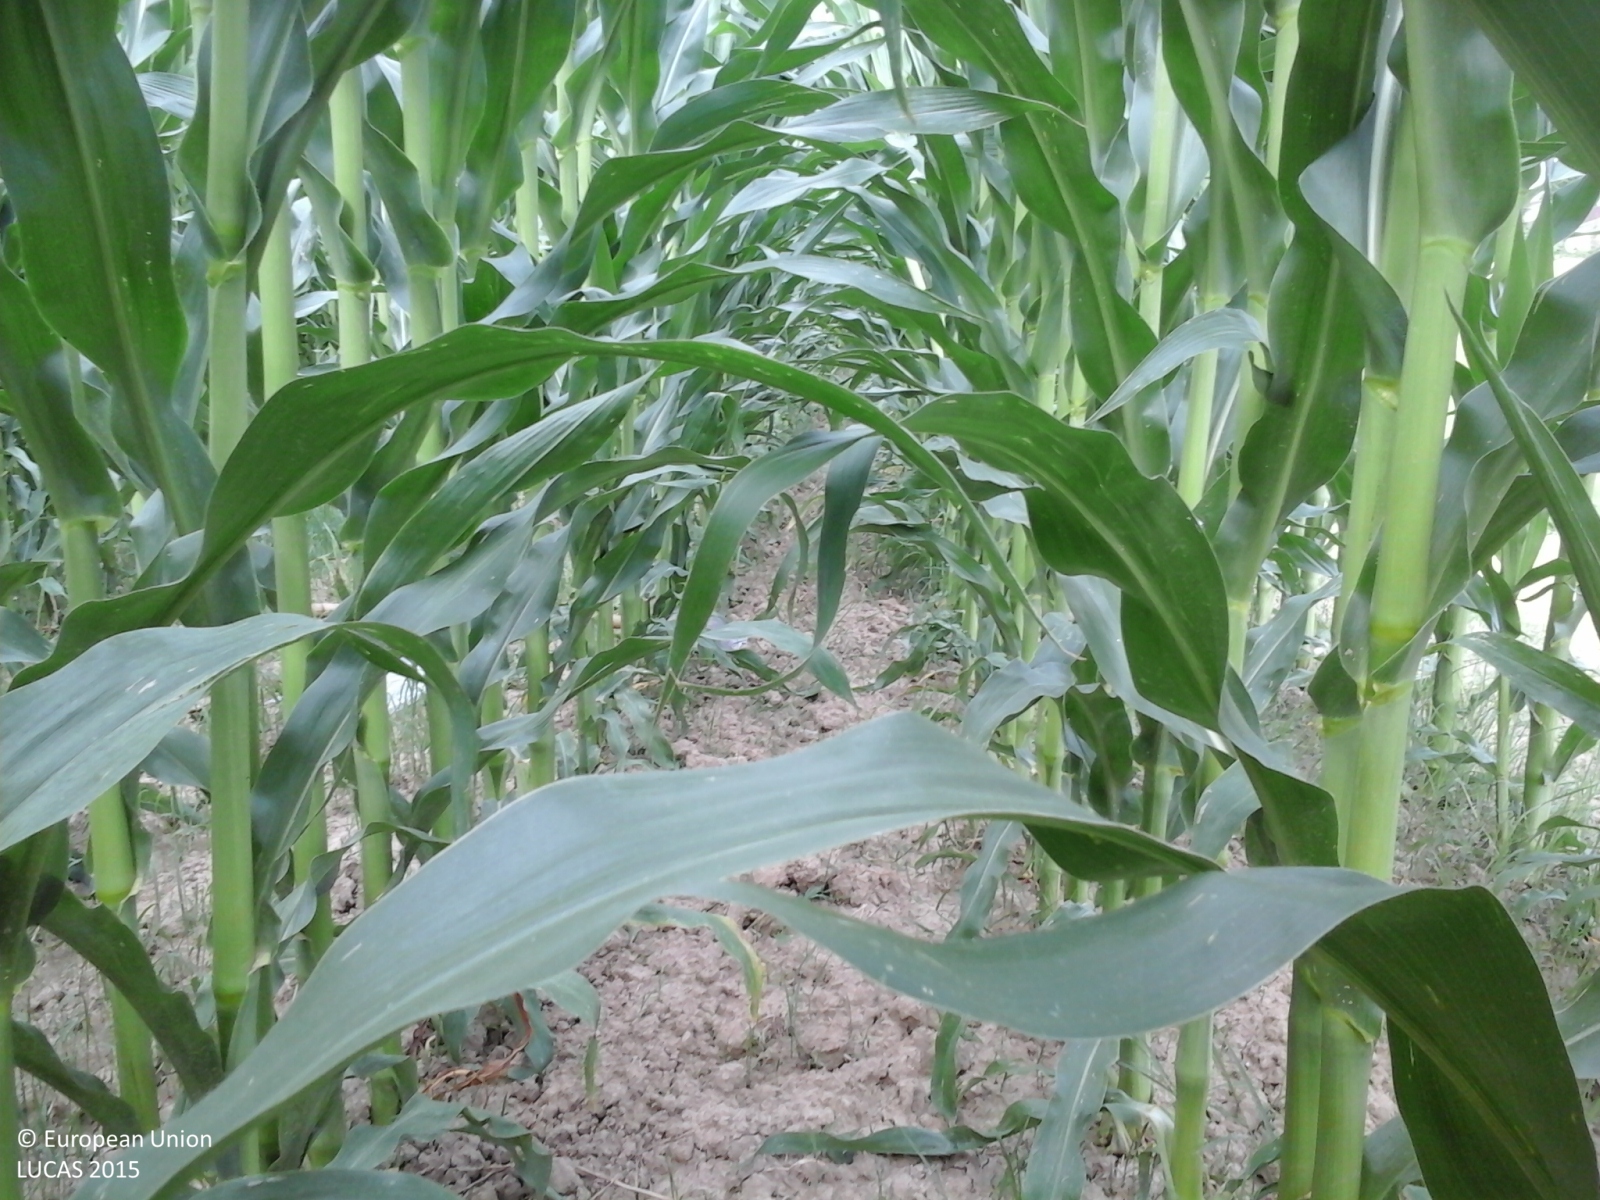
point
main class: Cropland
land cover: Maize
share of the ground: > 75 %
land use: Agriculture (excluding fallow land and kitchen gardens)
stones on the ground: < 10 %
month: June
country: IT
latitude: 45.2274
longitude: 11.1823
